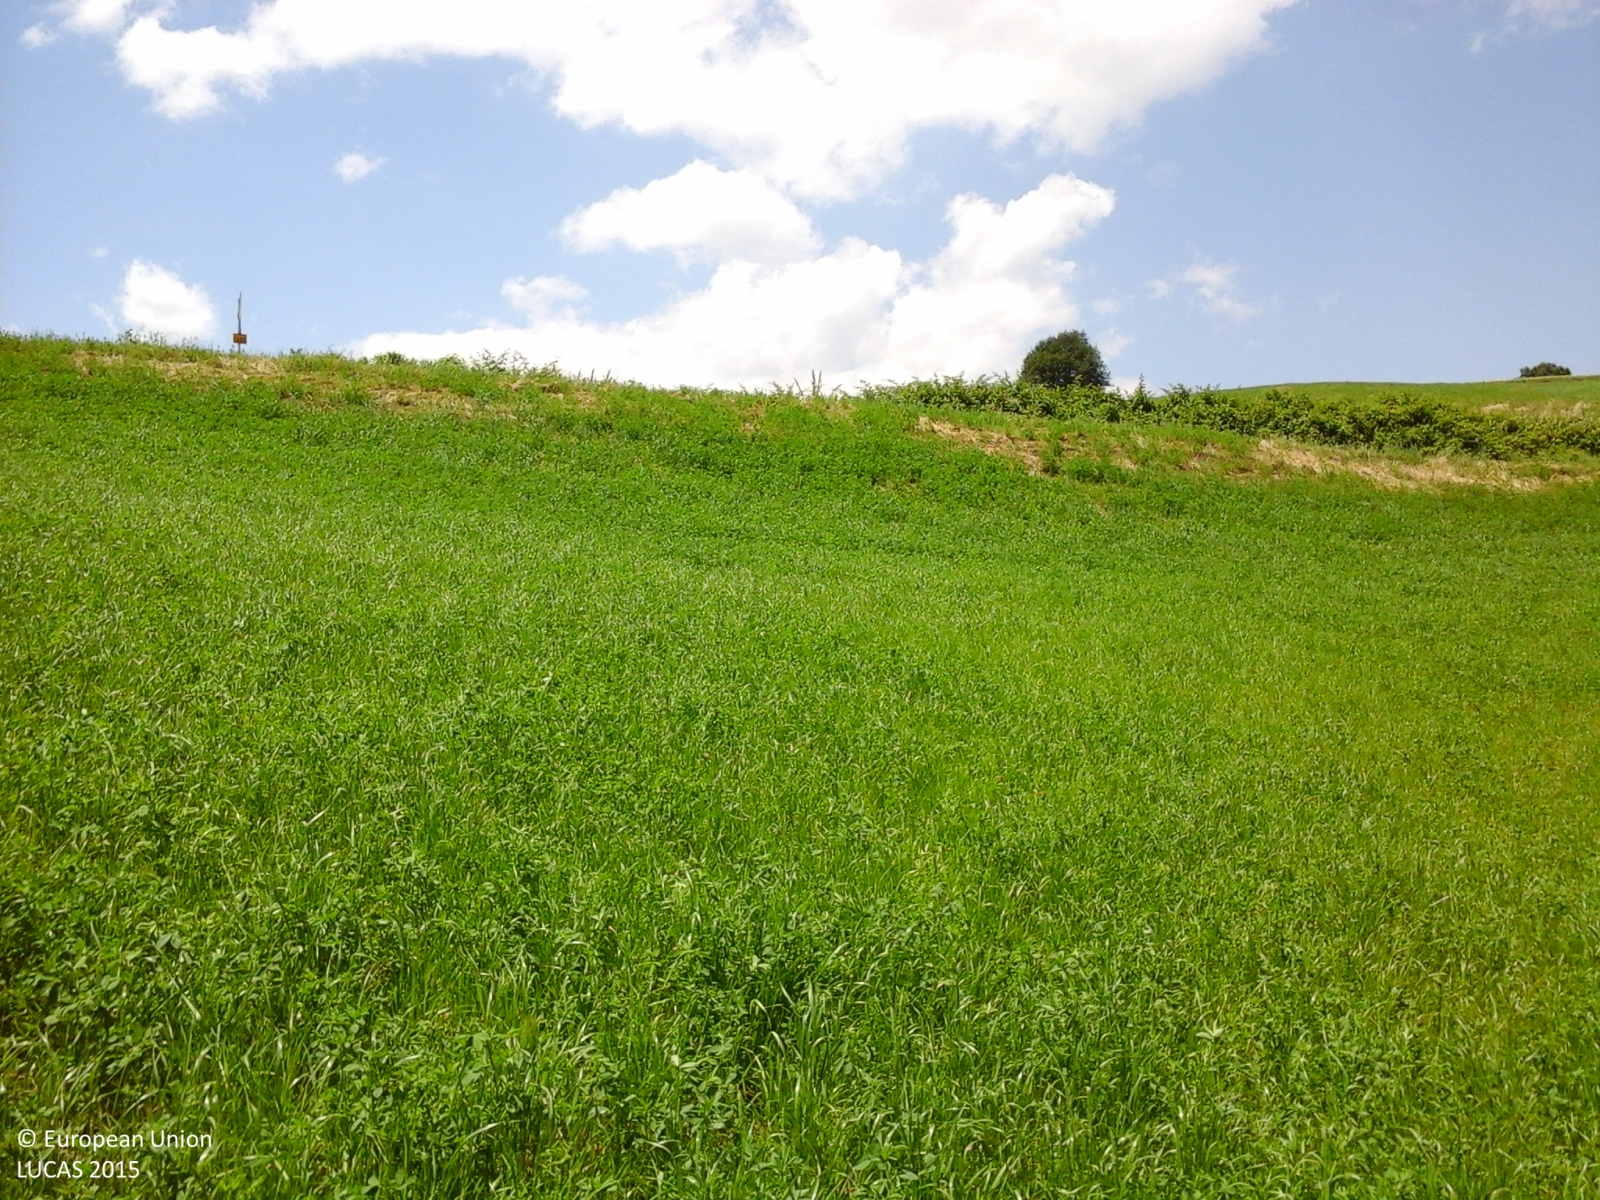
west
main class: Cropland
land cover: Lucerne
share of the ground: > 75 %
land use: Agriculture (excluding fallow land and kitchen gardens)
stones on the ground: < 10 %
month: May
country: IT
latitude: 44.7292
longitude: 10.0630
